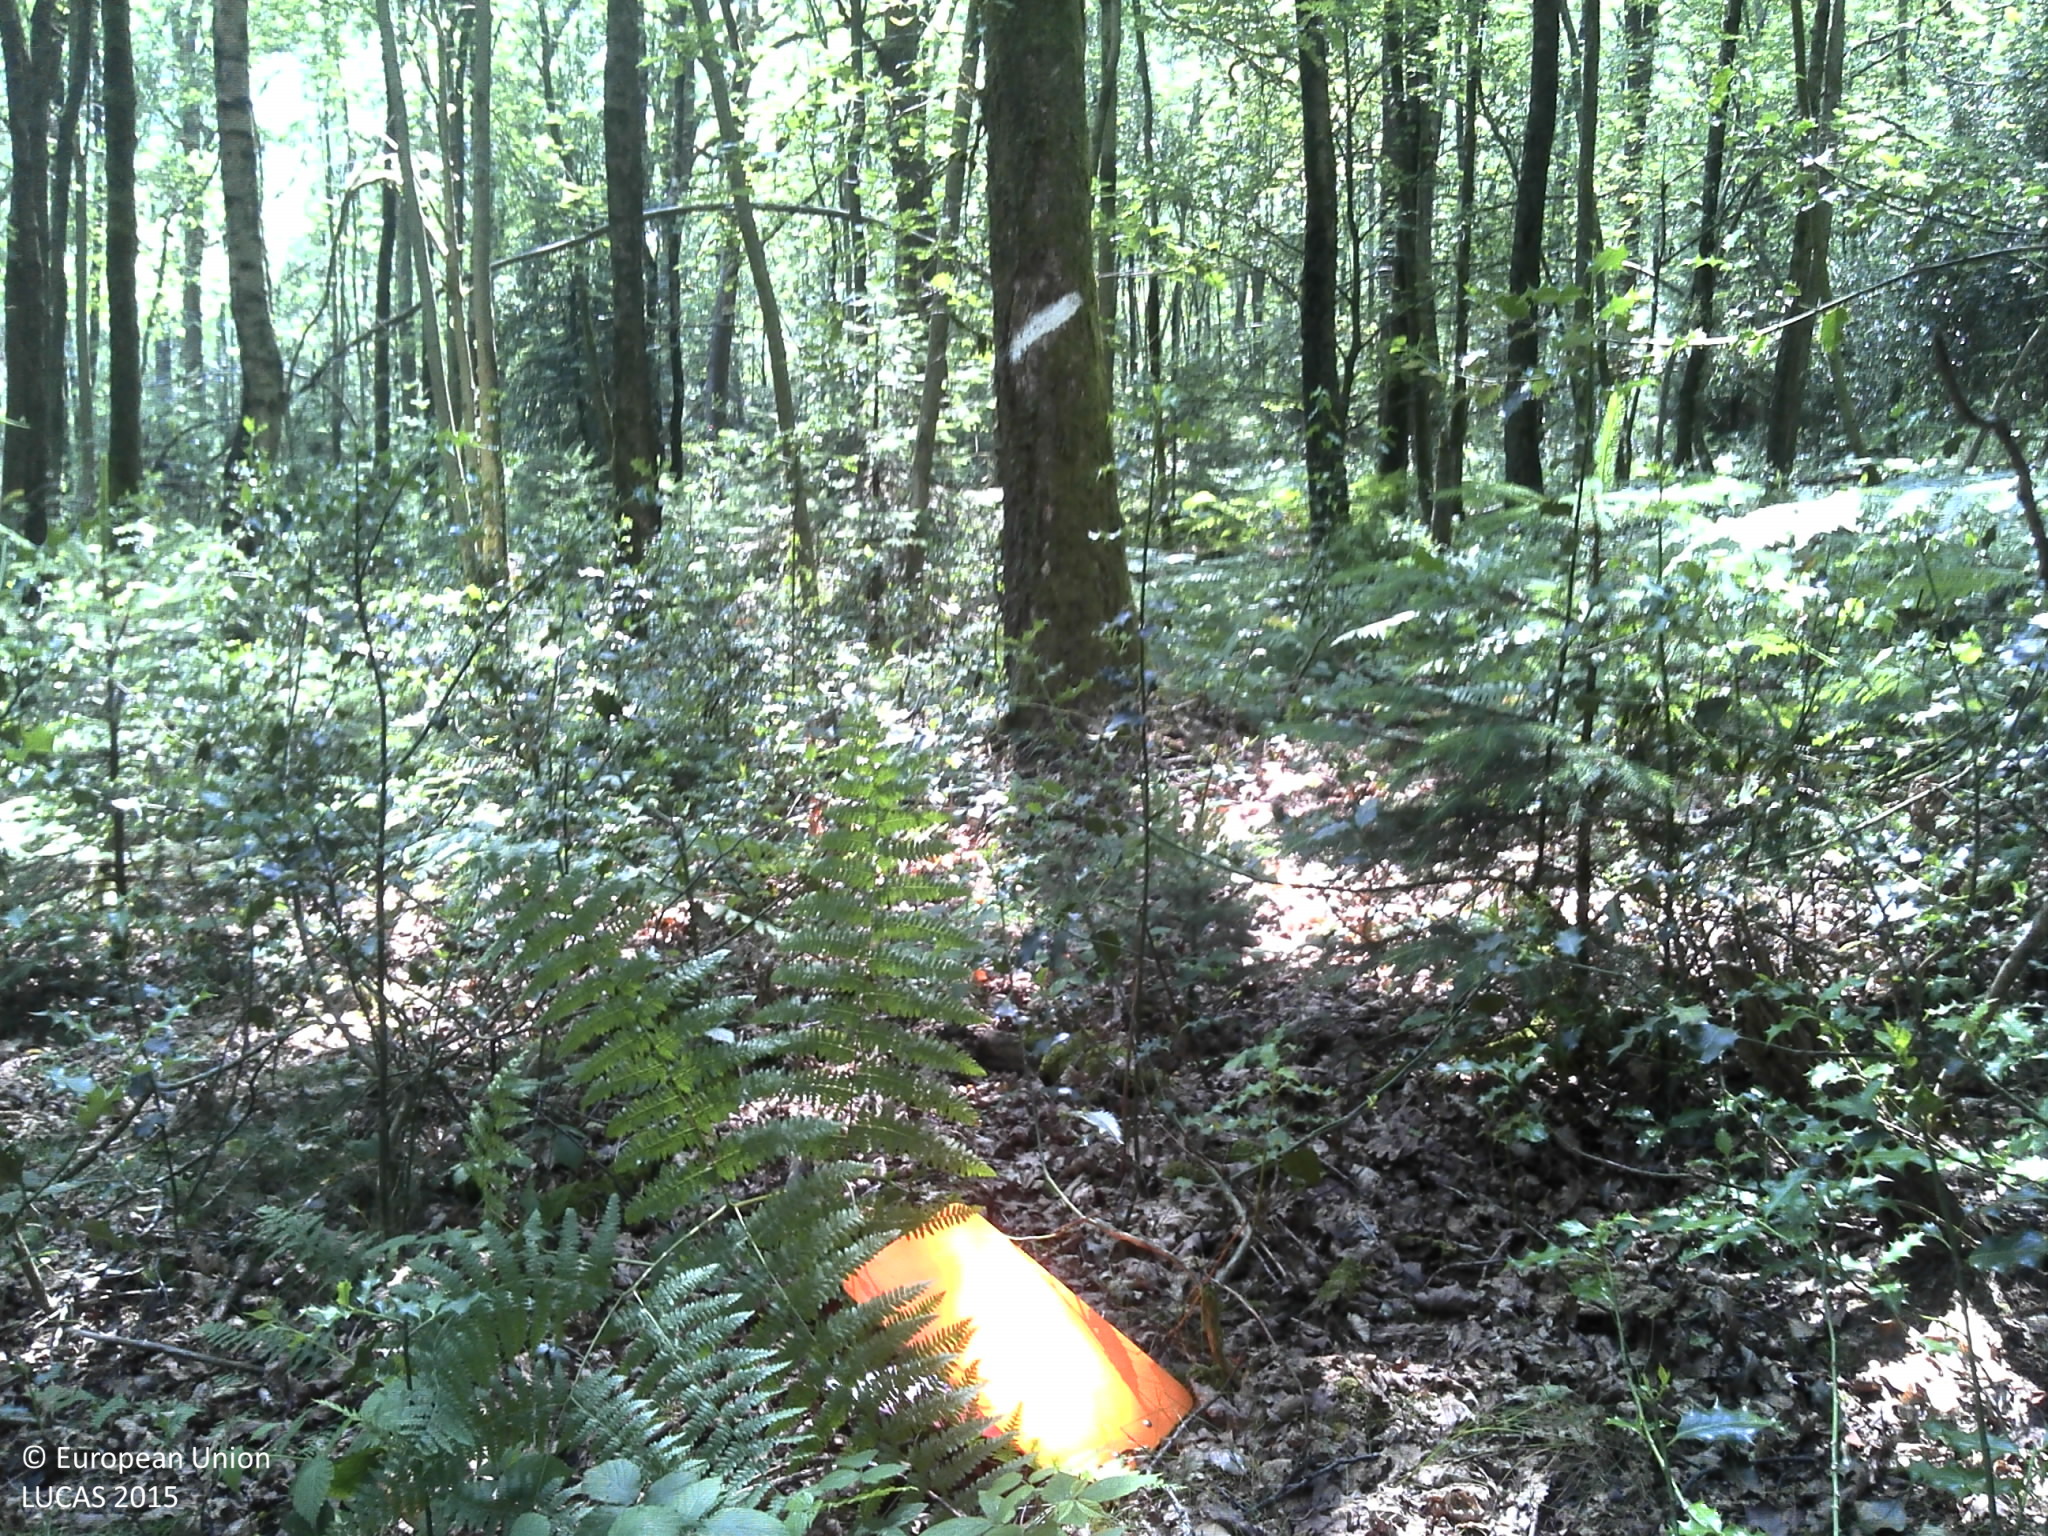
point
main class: Woodland
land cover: Broadleaved woodland
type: acidophilous oak and oak-birch forest
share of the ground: 50 - 75 %
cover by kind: broadleaved forest trees 60 %, herbaceous plants 20 %, coniferous forest trees 10 %, consolidated bare surface 10 %
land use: Forestry
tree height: > 5 m
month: July
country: FR
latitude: 49.9036
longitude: 4.8035
